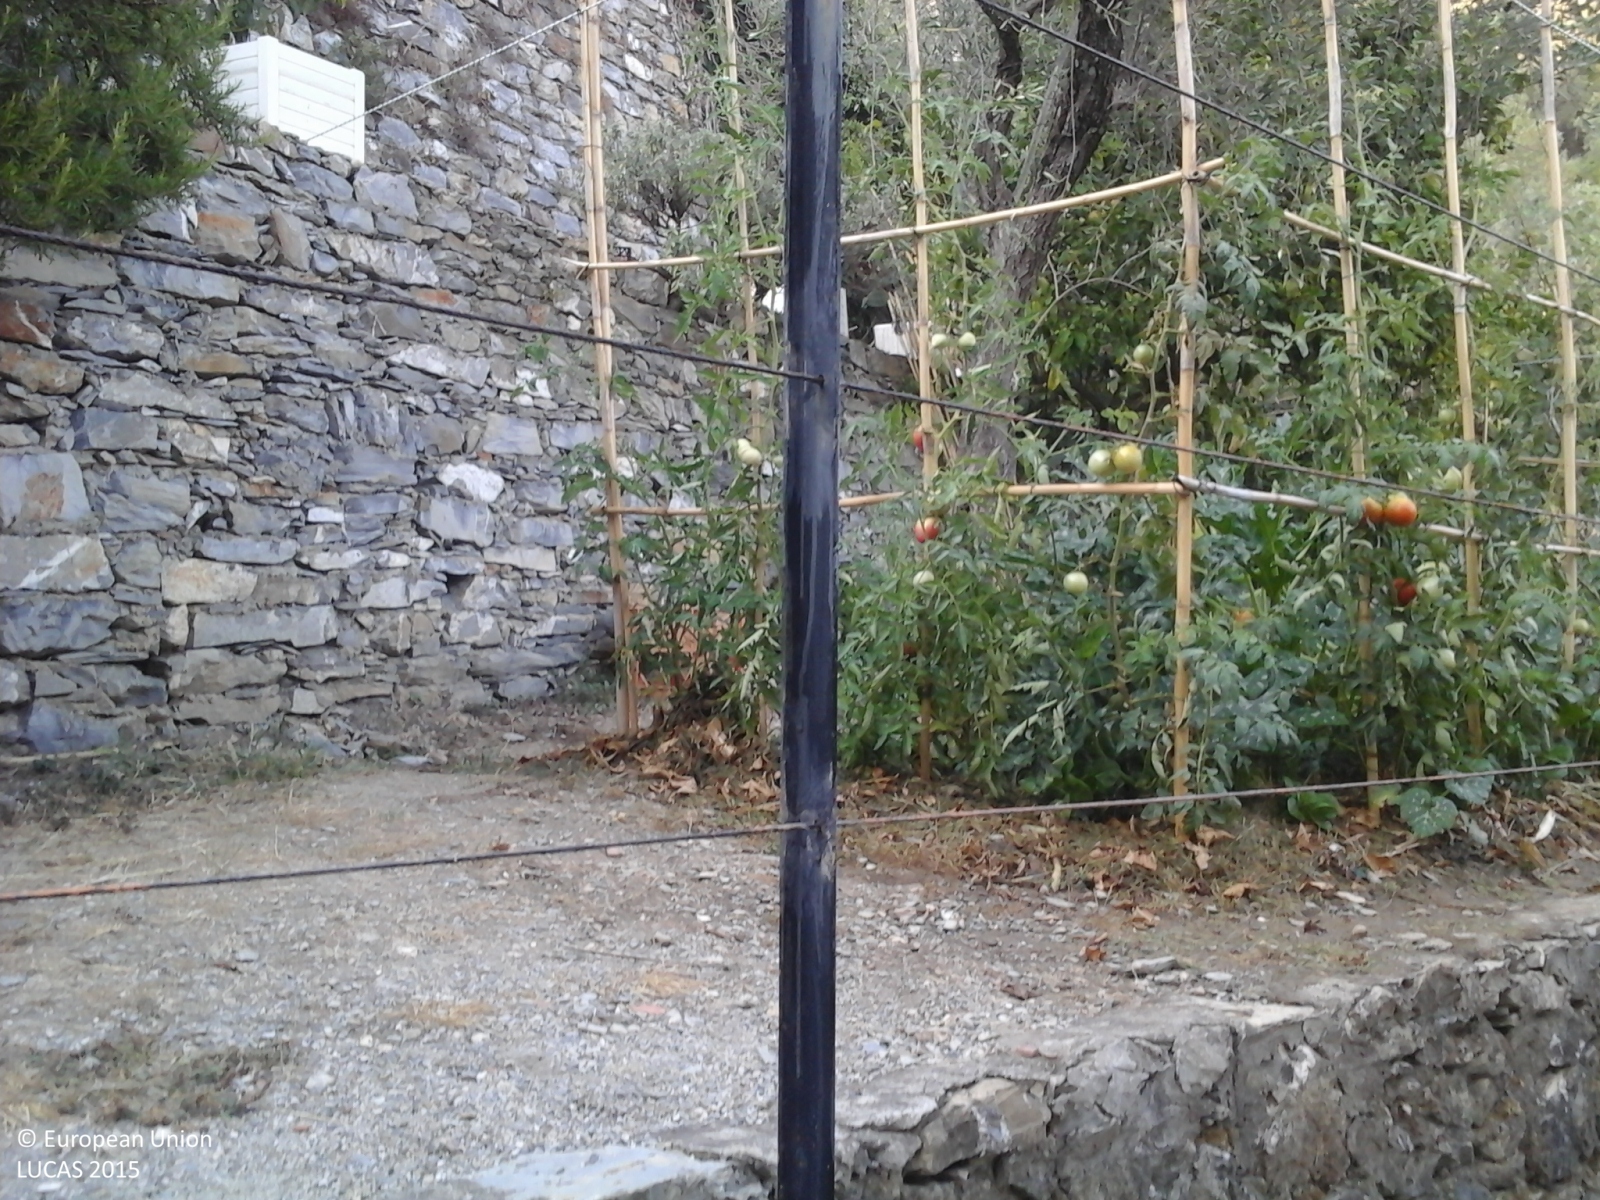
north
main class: Woodland
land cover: Broadleaved woodland
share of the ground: > 75 %
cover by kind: broadleaved forest trees 70 %, herbaceous plants 15 %, shrubs 10 %, coniferous forest trees 5 %
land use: Residential
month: August
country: IT
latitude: 44.3650
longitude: 9.1362
